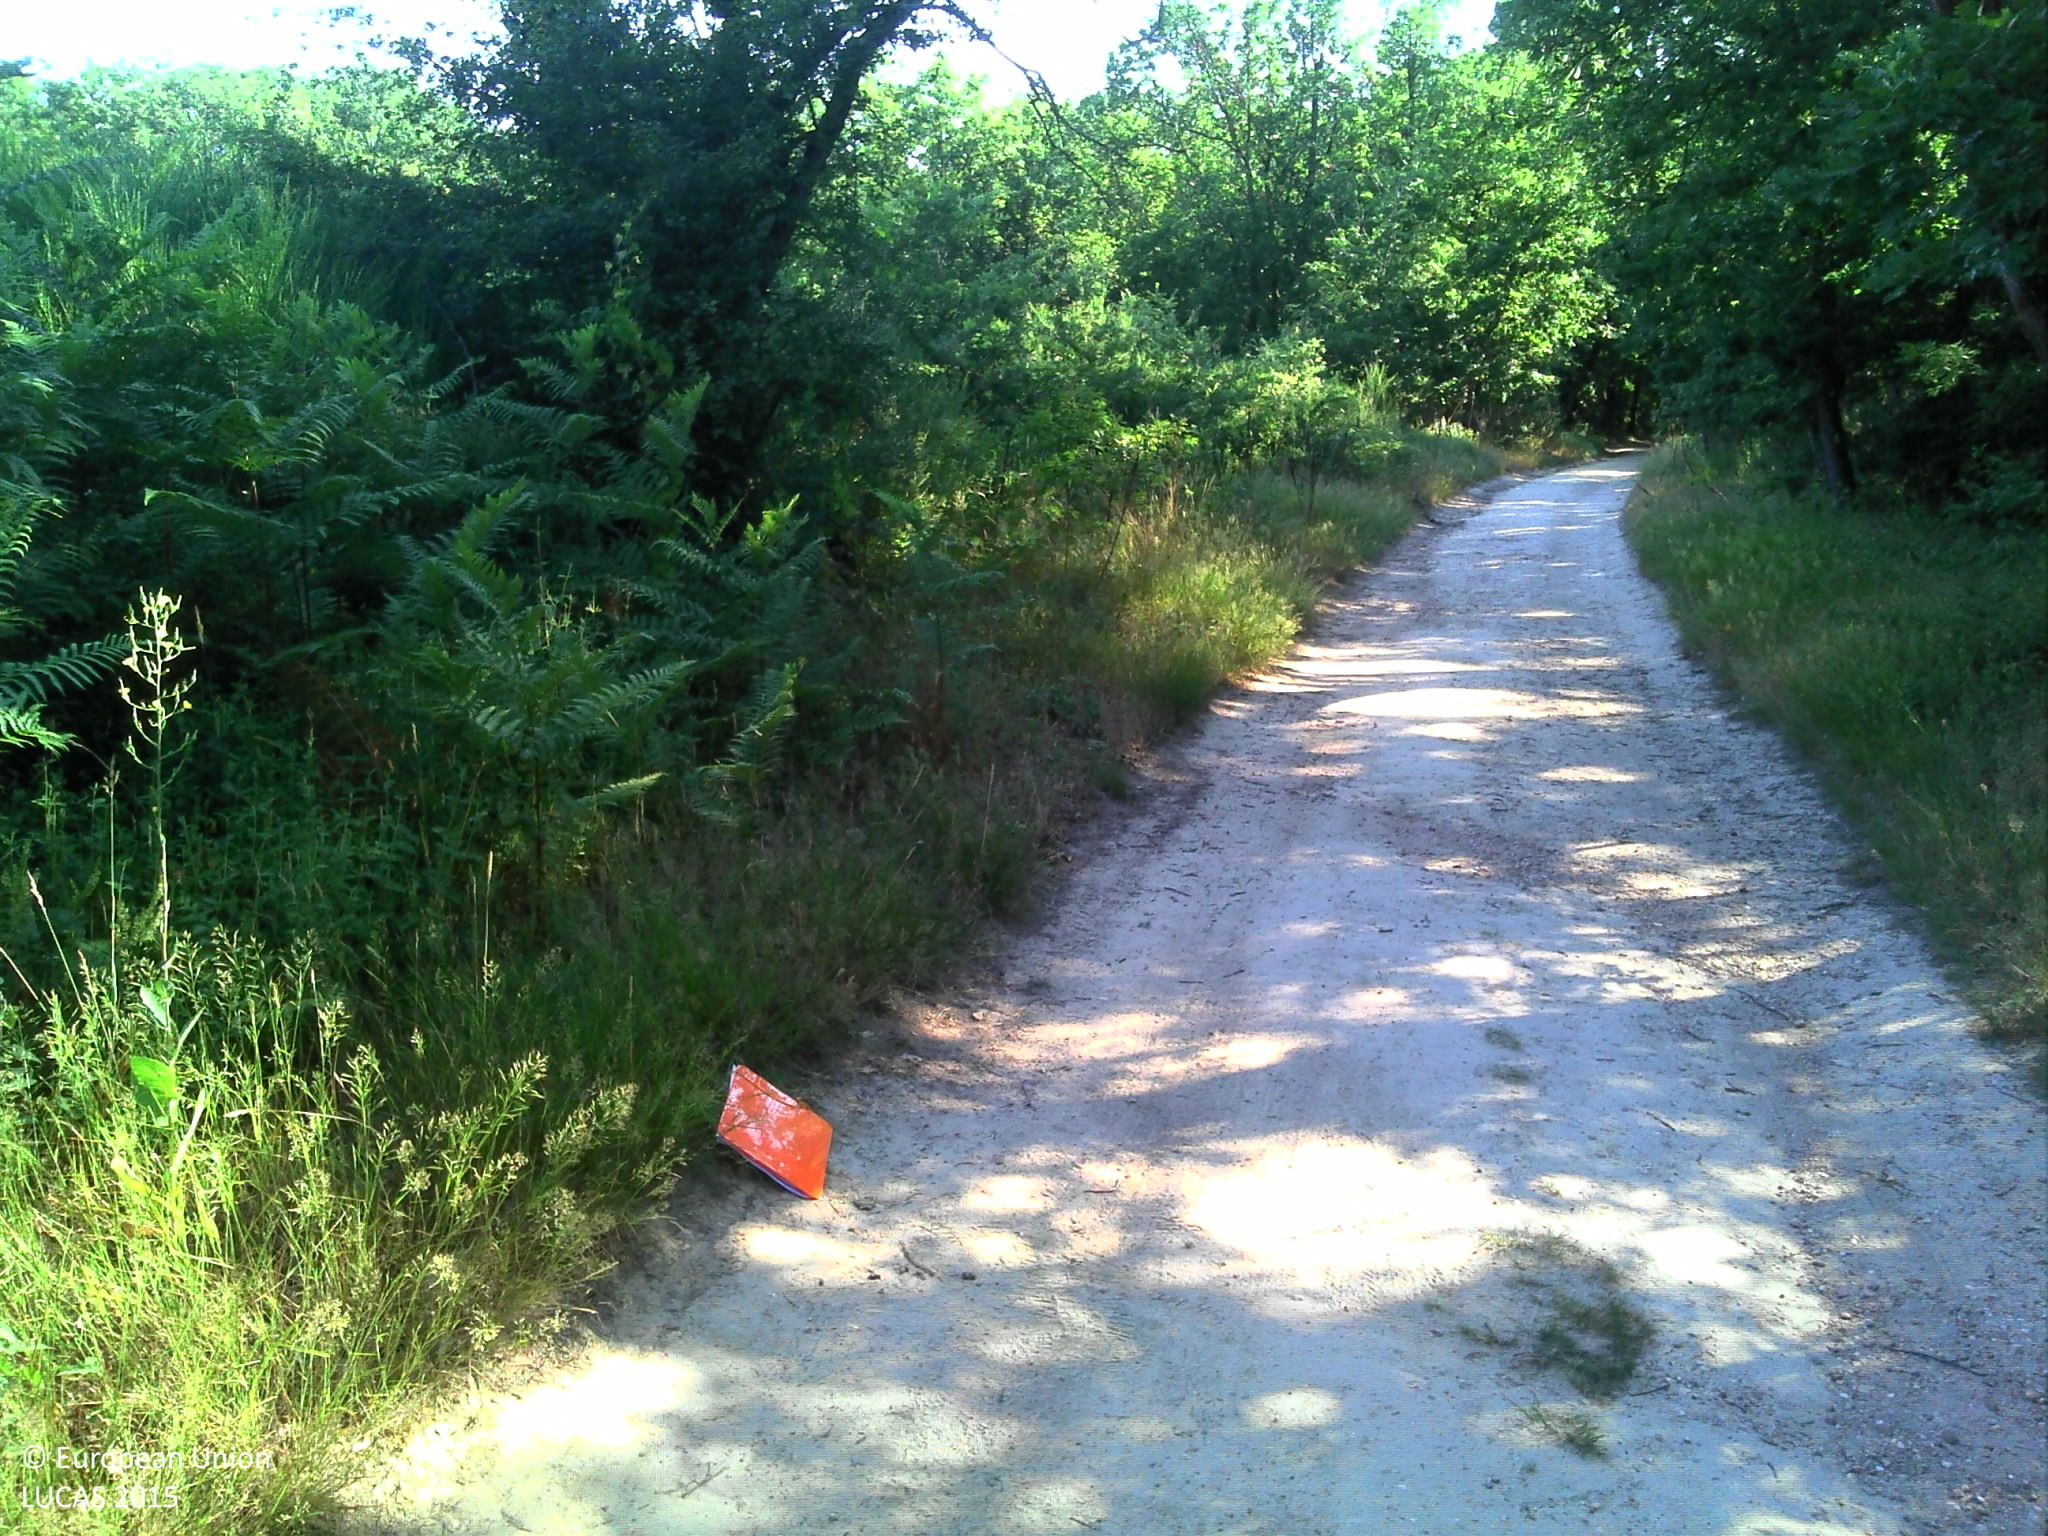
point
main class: Grassland
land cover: Spontaneously vegetated surfaces
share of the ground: > 75 %
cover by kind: herbaceous plants 60 %, lichens and mosses 15 %, shrubs 5 %
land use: Forestry
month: June
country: FR
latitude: 43.7711
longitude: 1.5669
